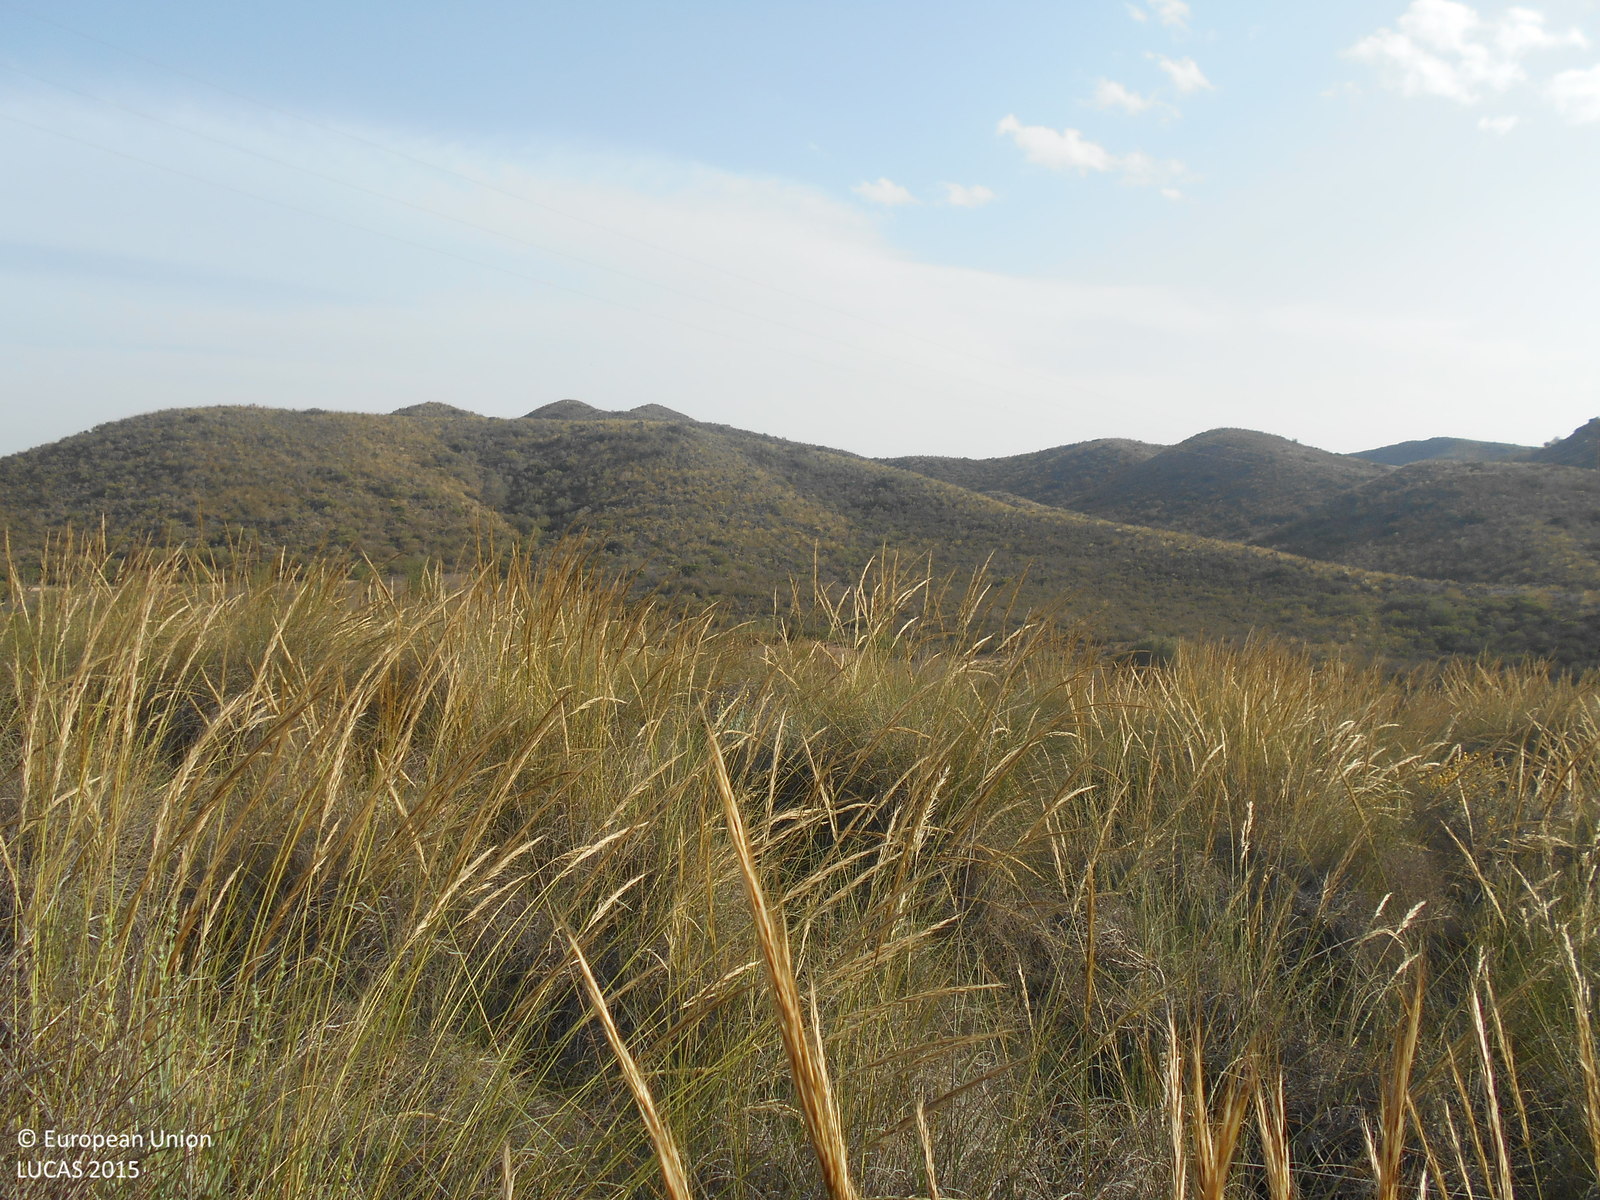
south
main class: Shrubland
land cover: Shrubland without tree cover
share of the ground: > 75 %
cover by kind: shrubs 95 %, unconsolidated bare surface 5 %
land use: Semi-natural and natural areas not in use
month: April
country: ES
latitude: 37.6746
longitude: -1.3074
